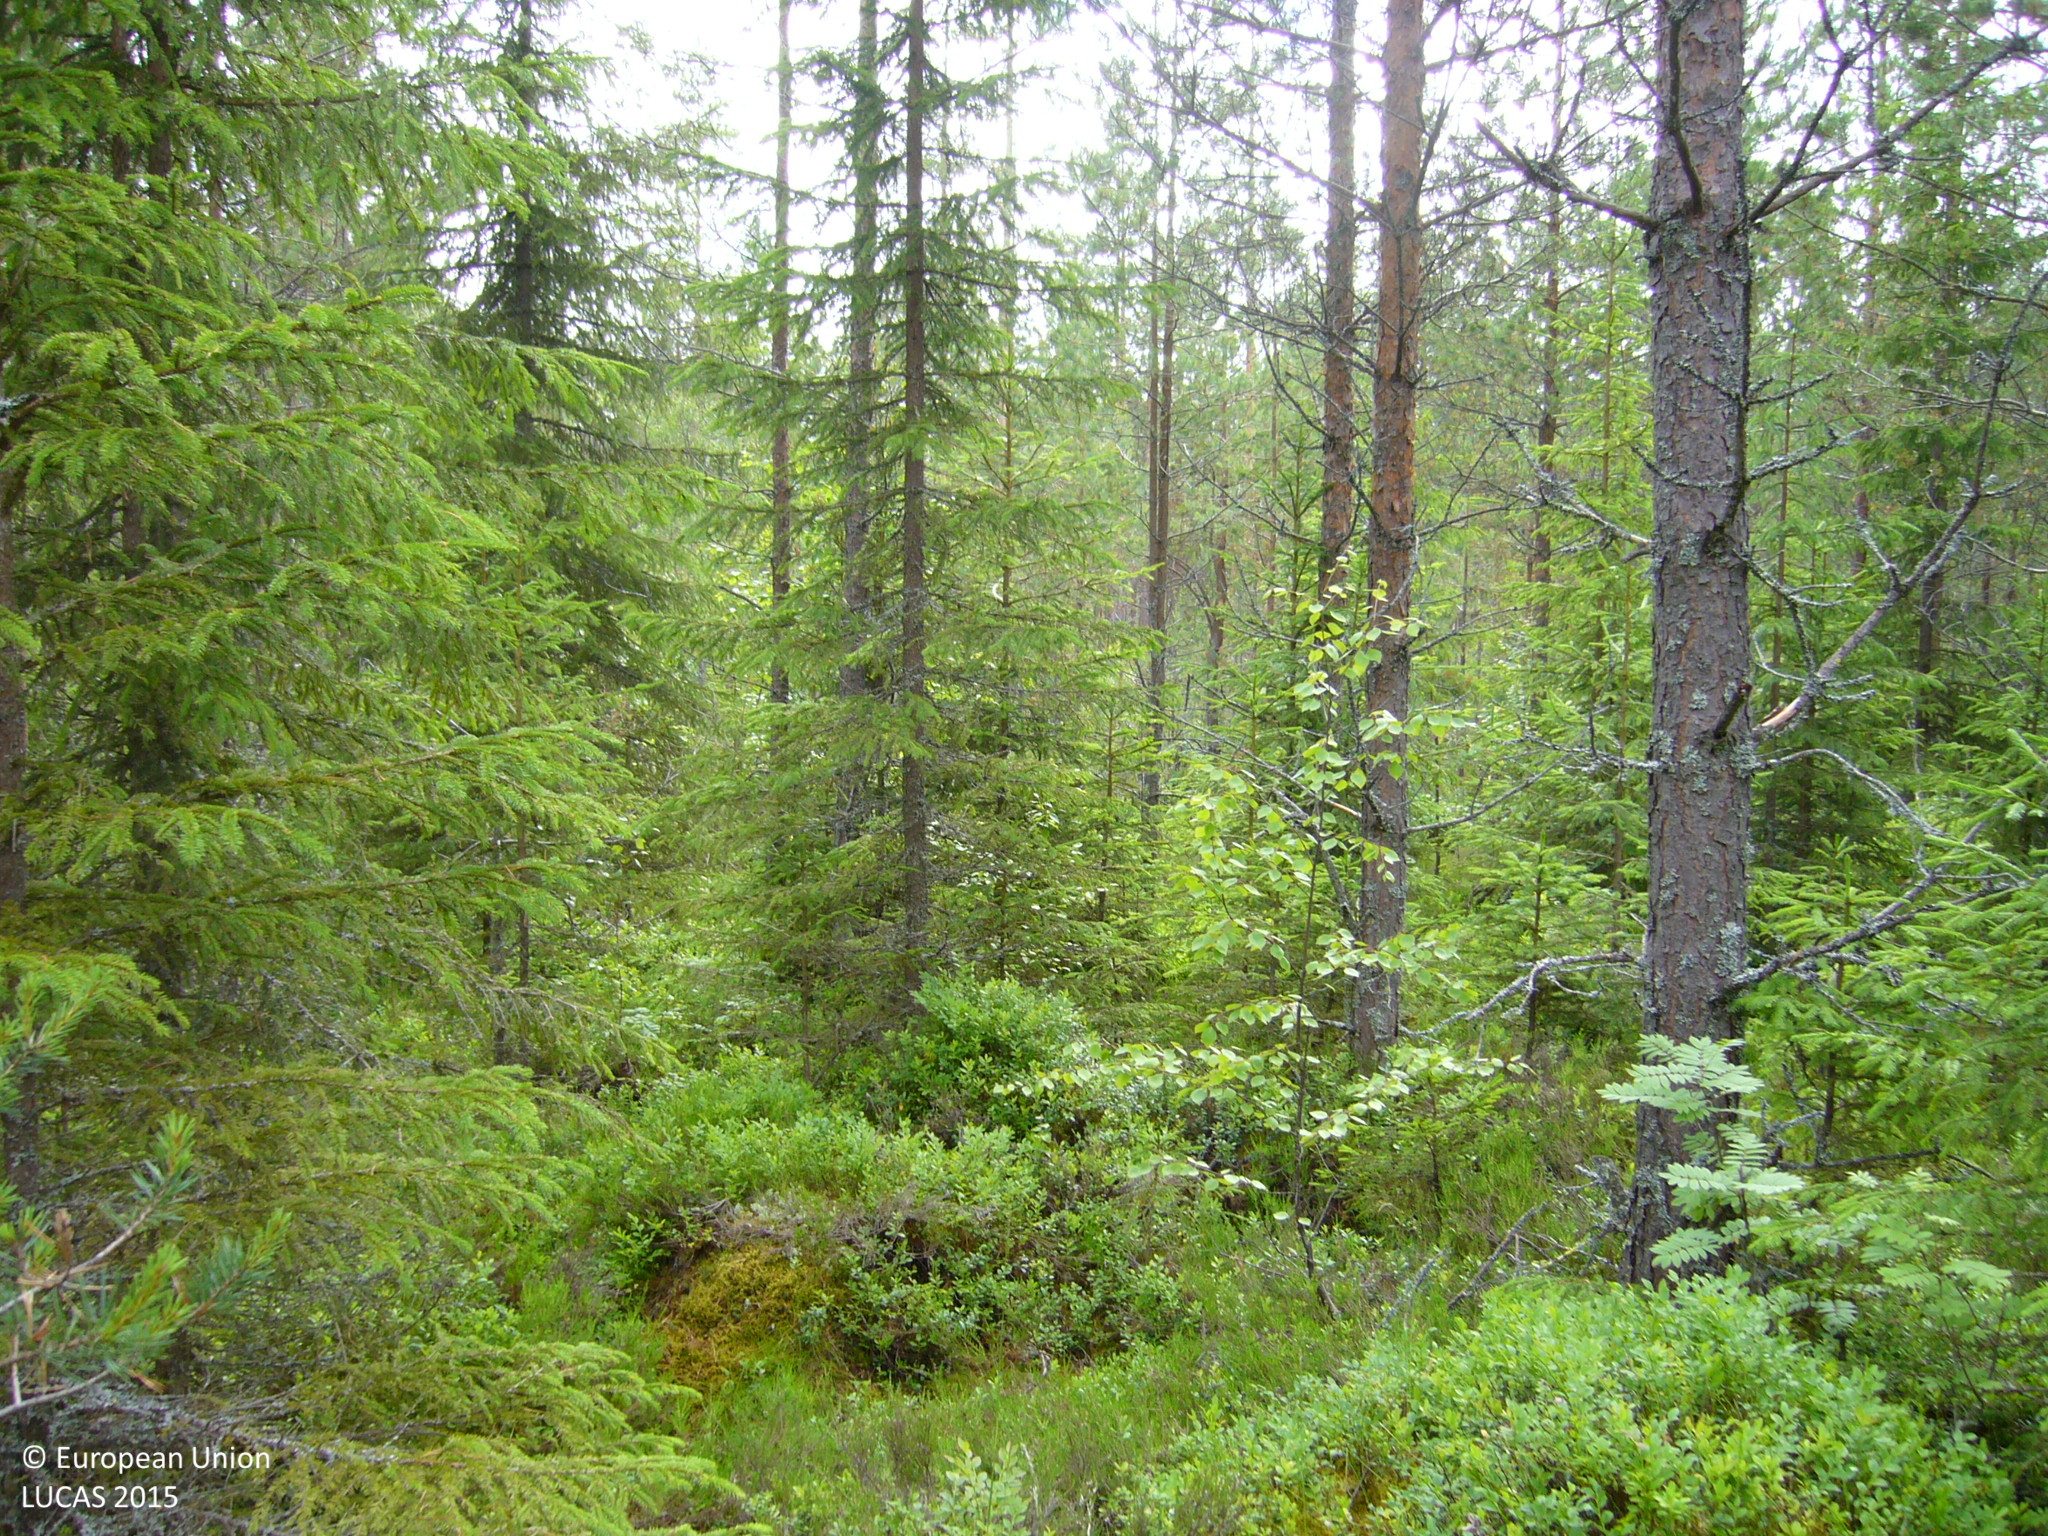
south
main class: Woodland
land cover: Pine dominated coniferous woodland
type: boreal forest
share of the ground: 50 - 75 %
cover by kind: coniferous forest trees 60 %, shrubs 40 %
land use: Forestry
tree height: > 5 m
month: July
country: FI
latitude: 63.5616
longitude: 25.6248
